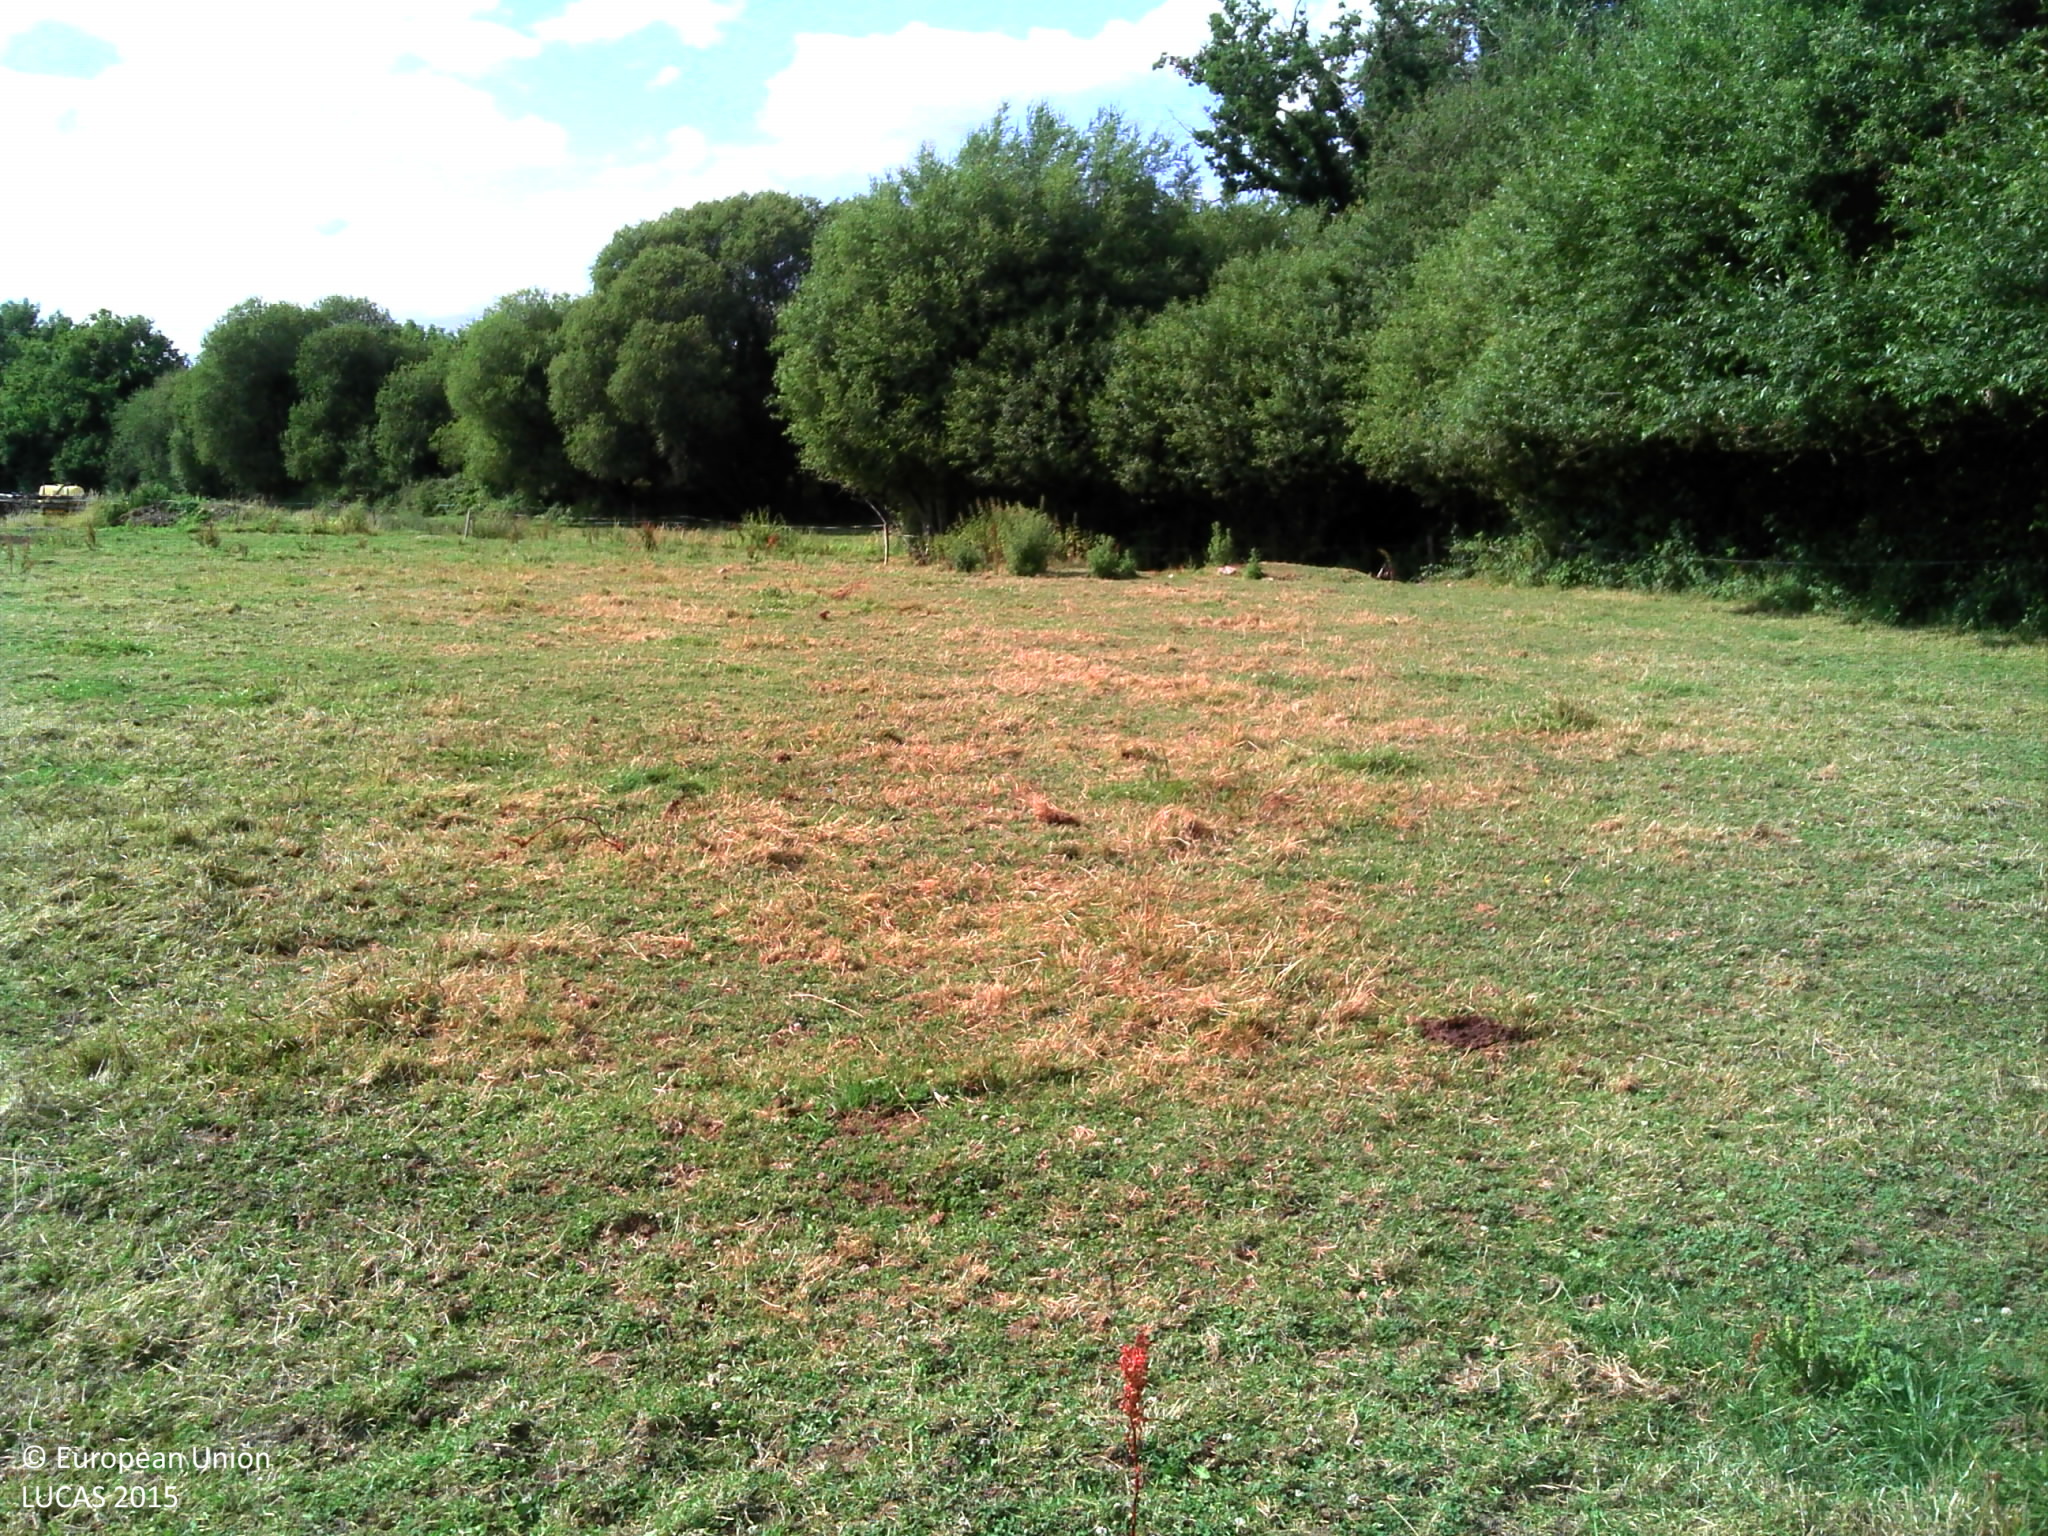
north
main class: Grassland
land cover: Grassland without tree/shrub cover
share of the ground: > 75 %
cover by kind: herbaceous plants 80 %, unconsolidated bare surface 20 %
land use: Agriculture (excluding fallow land and kitchen gardens)
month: July
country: FR
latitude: 48.2950
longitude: -2.1465
